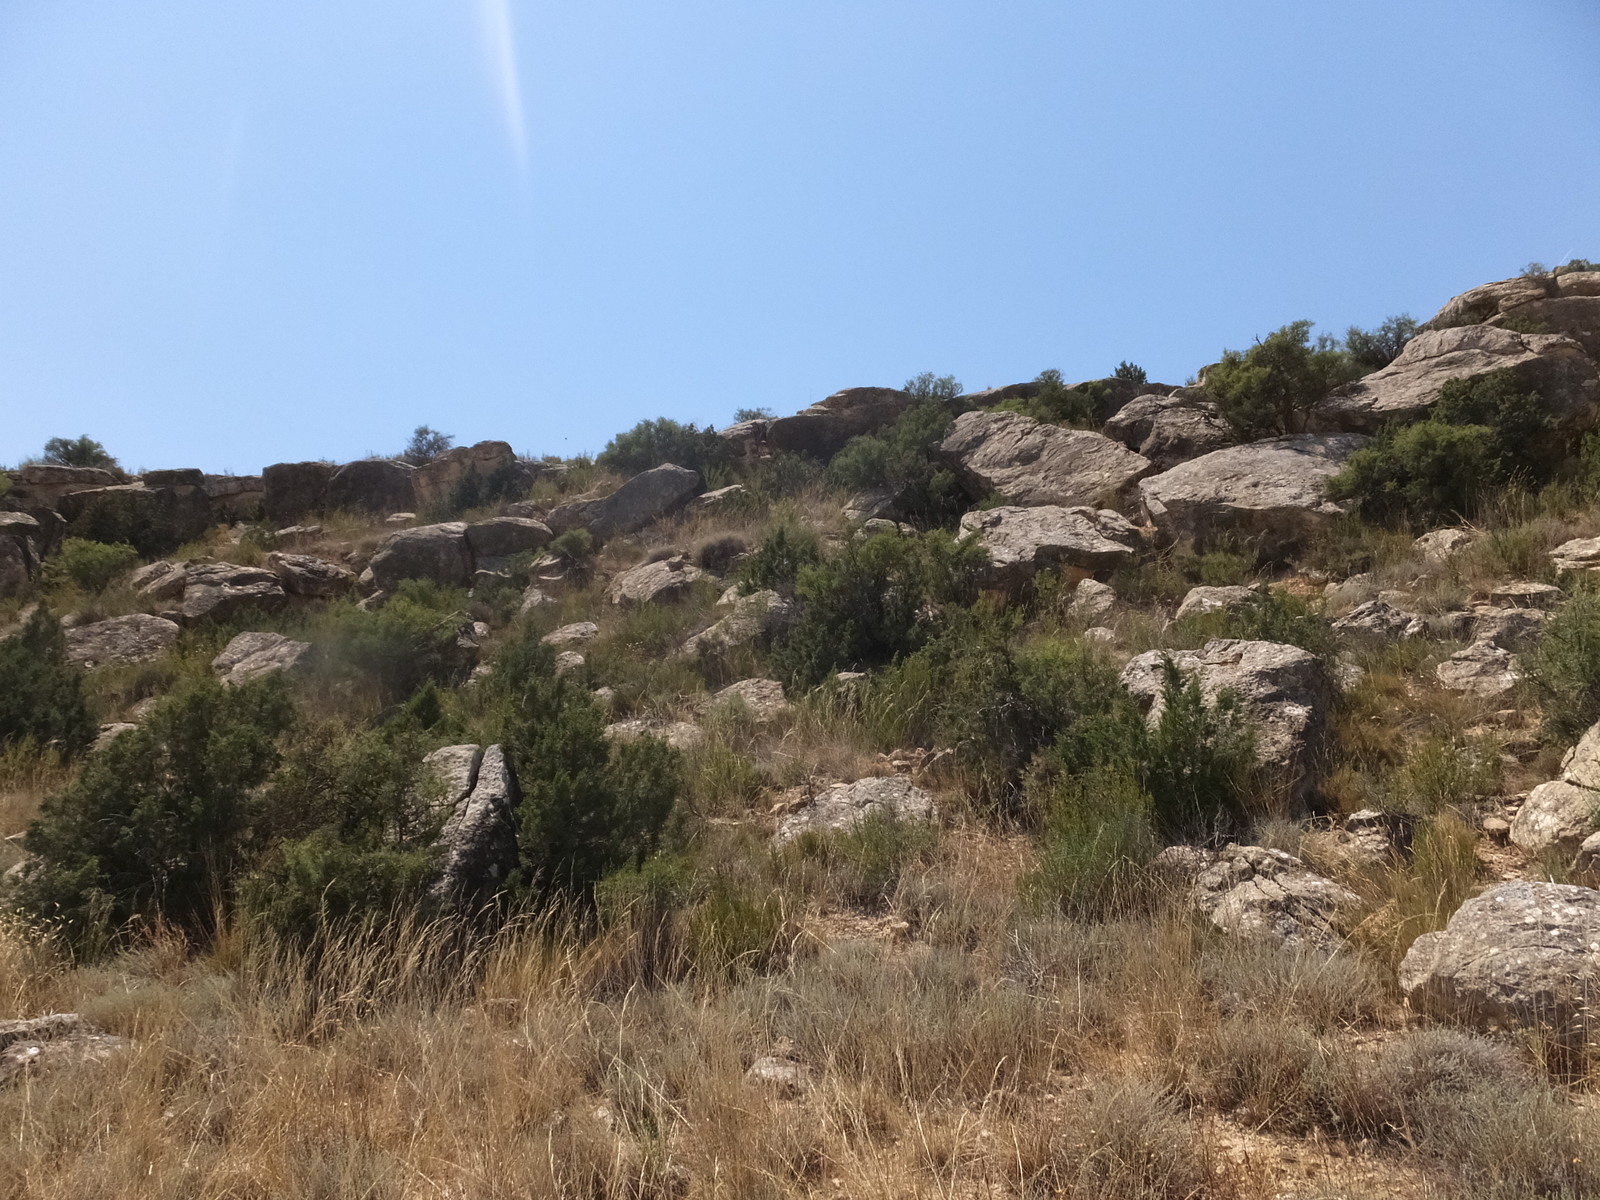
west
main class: Cropland
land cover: Barley
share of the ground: < 10 %
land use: Agriculture (excluding fallow land and kitchen gardens)
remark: Harvested field
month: June
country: ES
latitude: 41.2900
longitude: -0.1275
